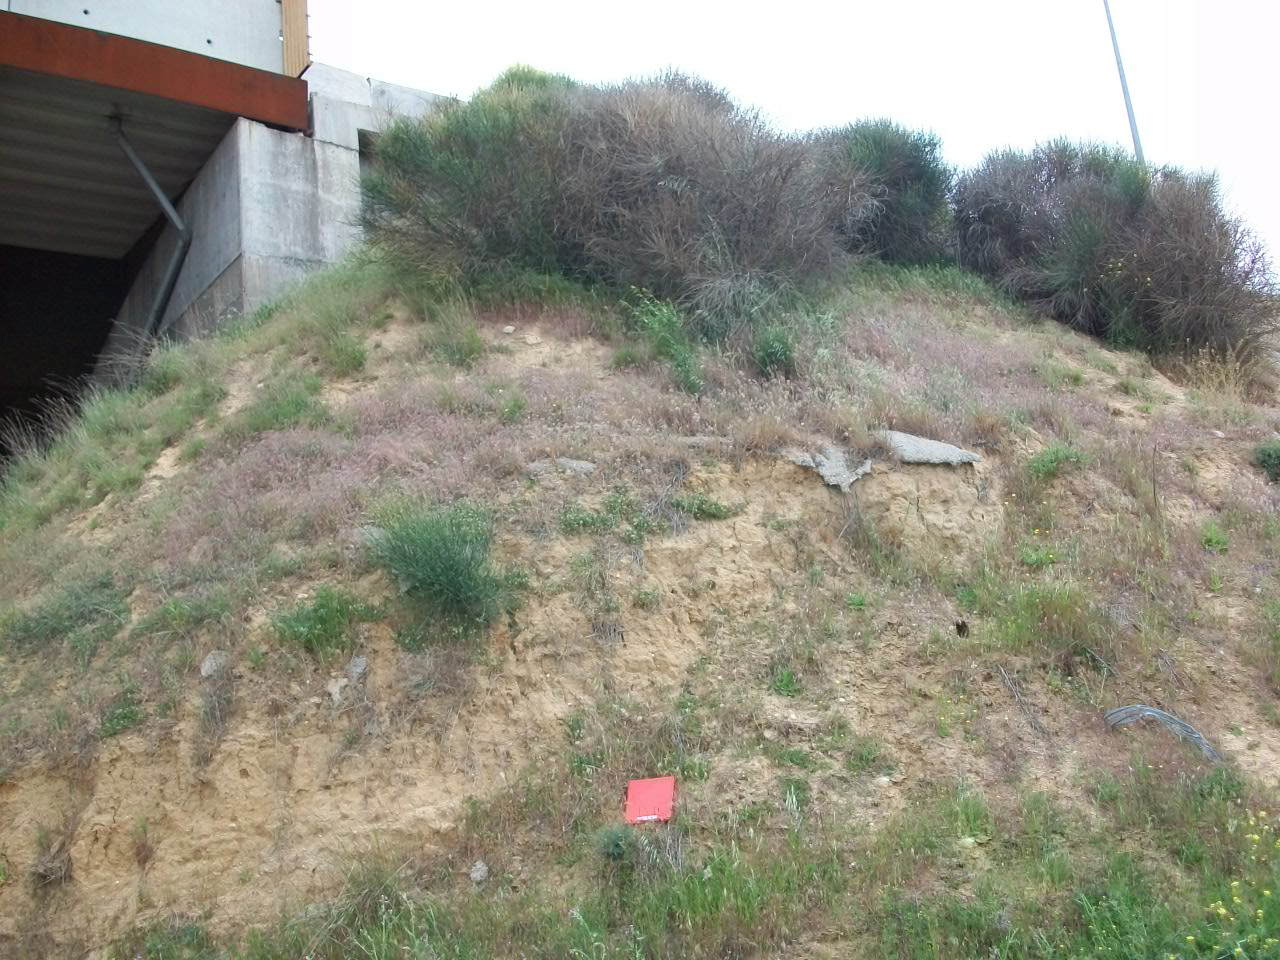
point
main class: Shrubland
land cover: Shrubland without tree cover
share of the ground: > 75 %
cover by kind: shrubs 95 %, herbaceous plants 5 %
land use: Abandoned areas
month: April
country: ES
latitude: 40.2751
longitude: -3.8088
